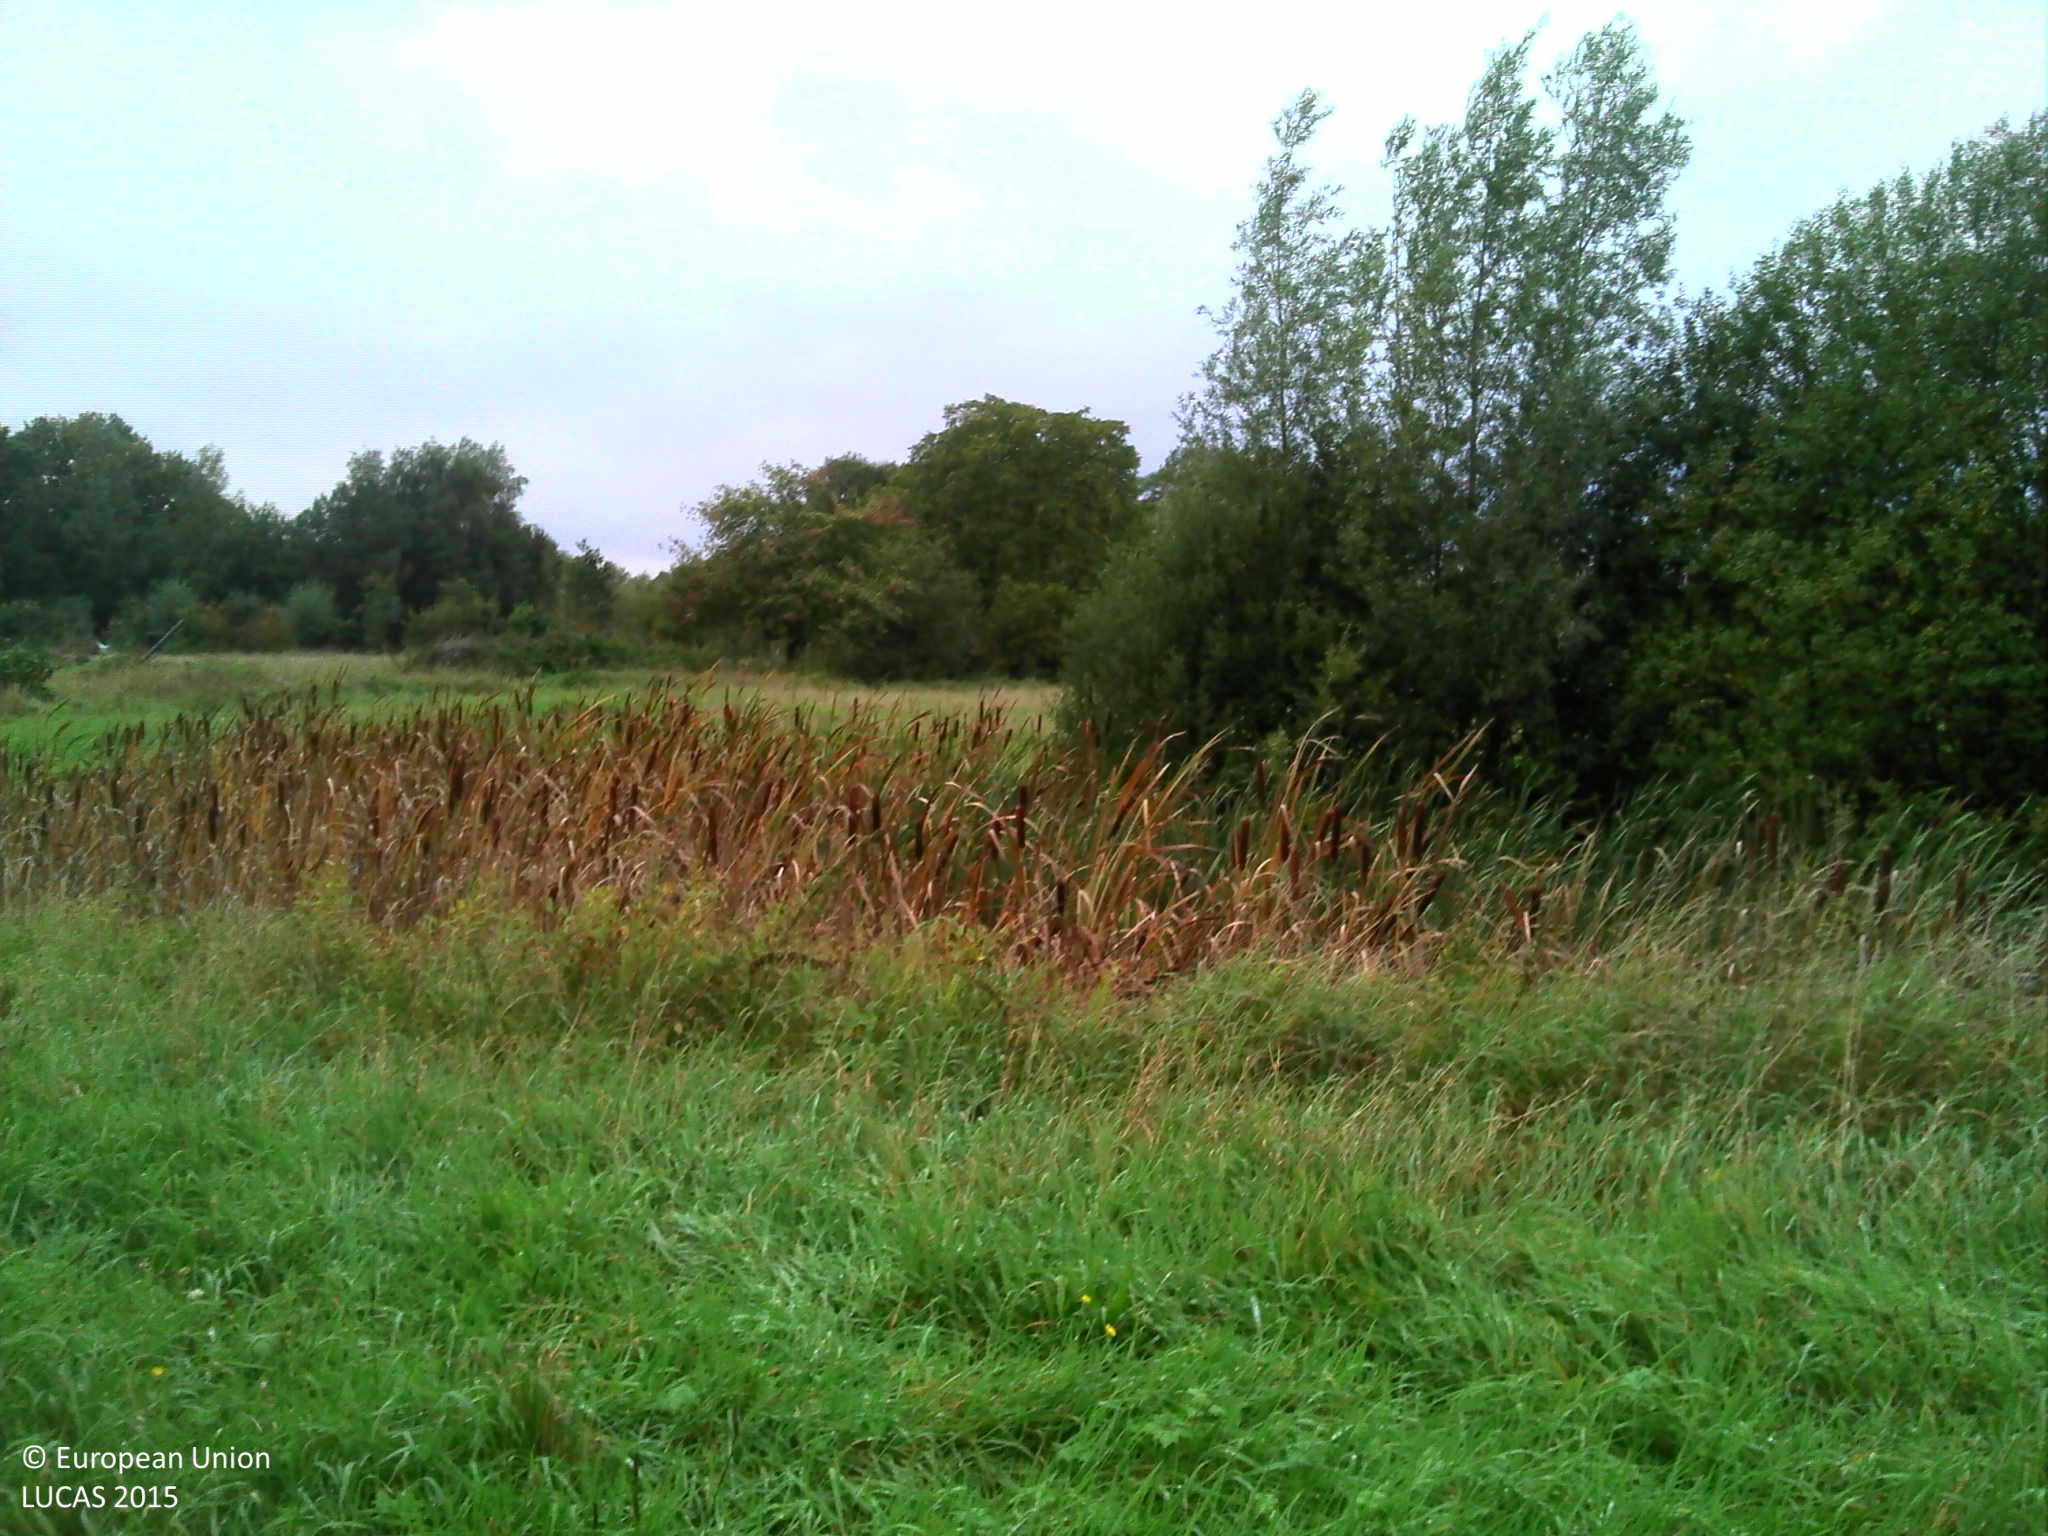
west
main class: Grassland
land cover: Grassland without tree/shrub cover
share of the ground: > 75 %
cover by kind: herbaceous plants 100 %
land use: Agriculture (excluding fallow land and kitchen gardens)
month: October
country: BE
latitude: 51.0549
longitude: 4.7606
